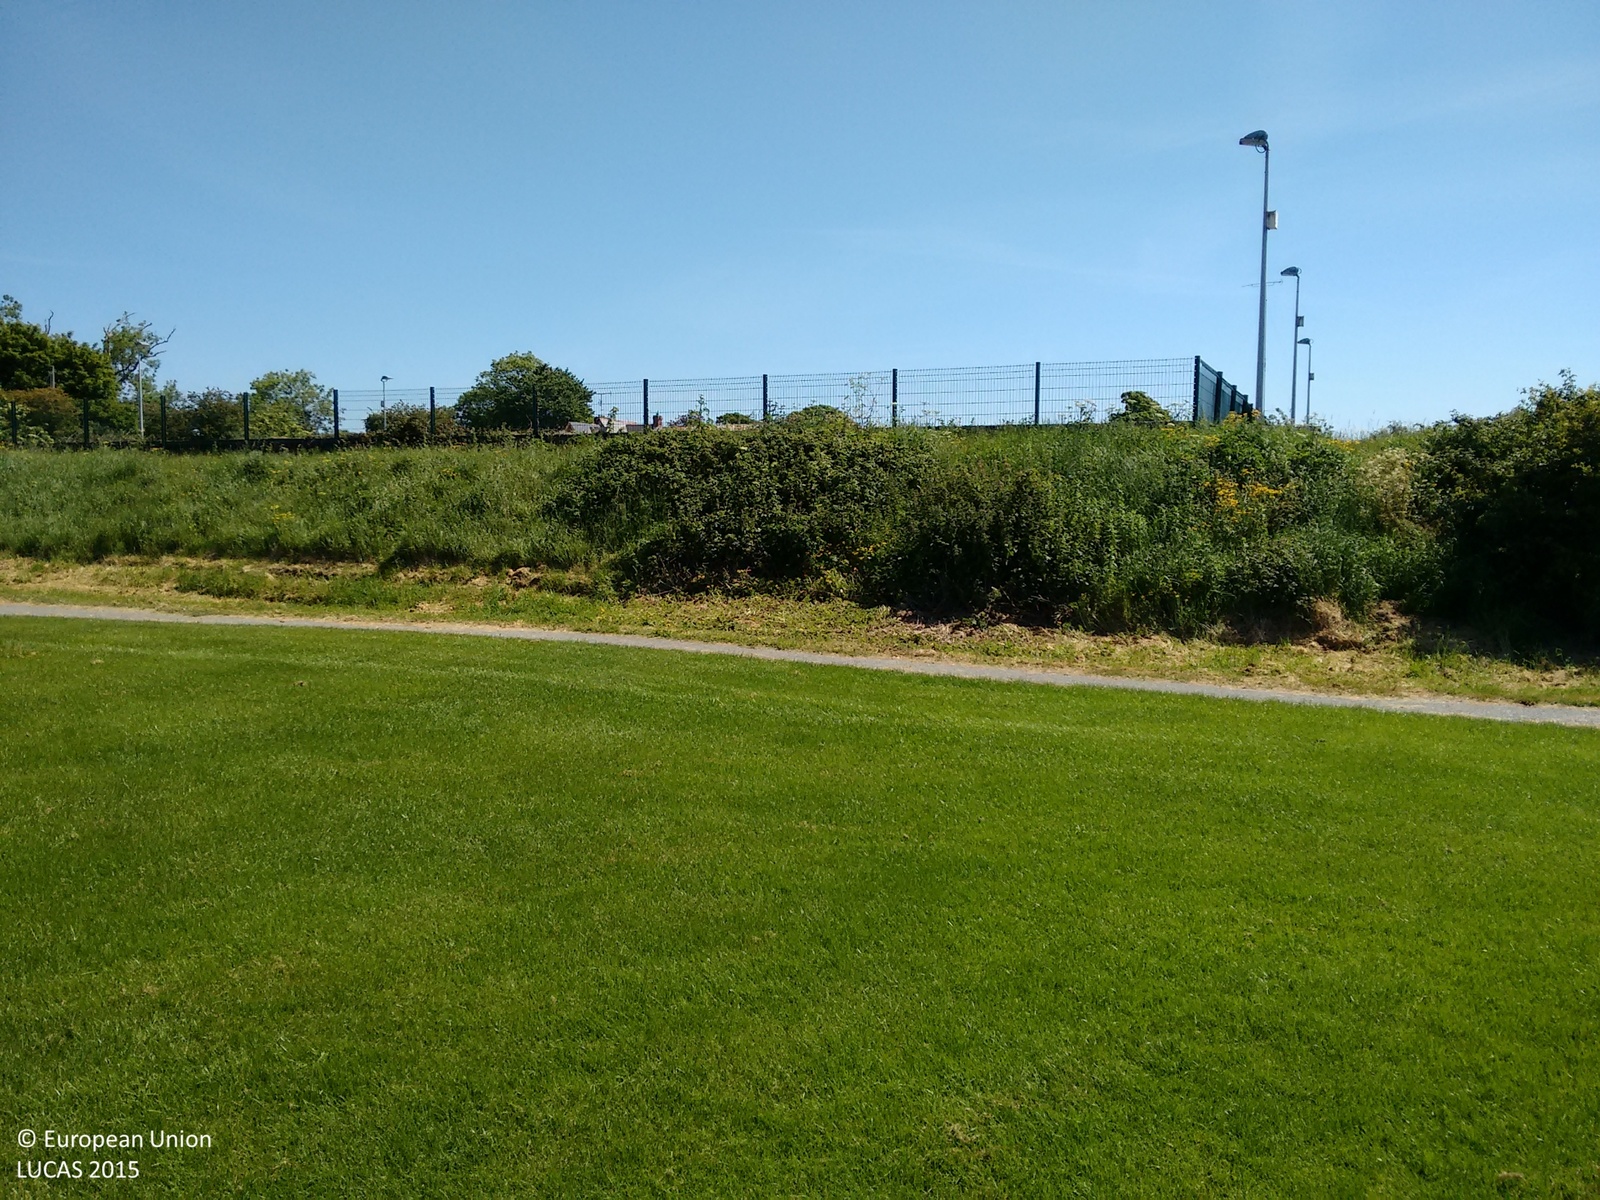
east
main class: Grassland
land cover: Grassland without tree/shrub cover
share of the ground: > 75 %
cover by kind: herbaceous plants 100 %
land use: Sport
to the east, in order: Grassland without tree/shrub cover; Grass margins; Artificial constructions in urban areas; Grass margins; Shrubland with sparse tree cover; Barley
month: June
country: IE
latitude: 53.4725
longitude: -6.2239
